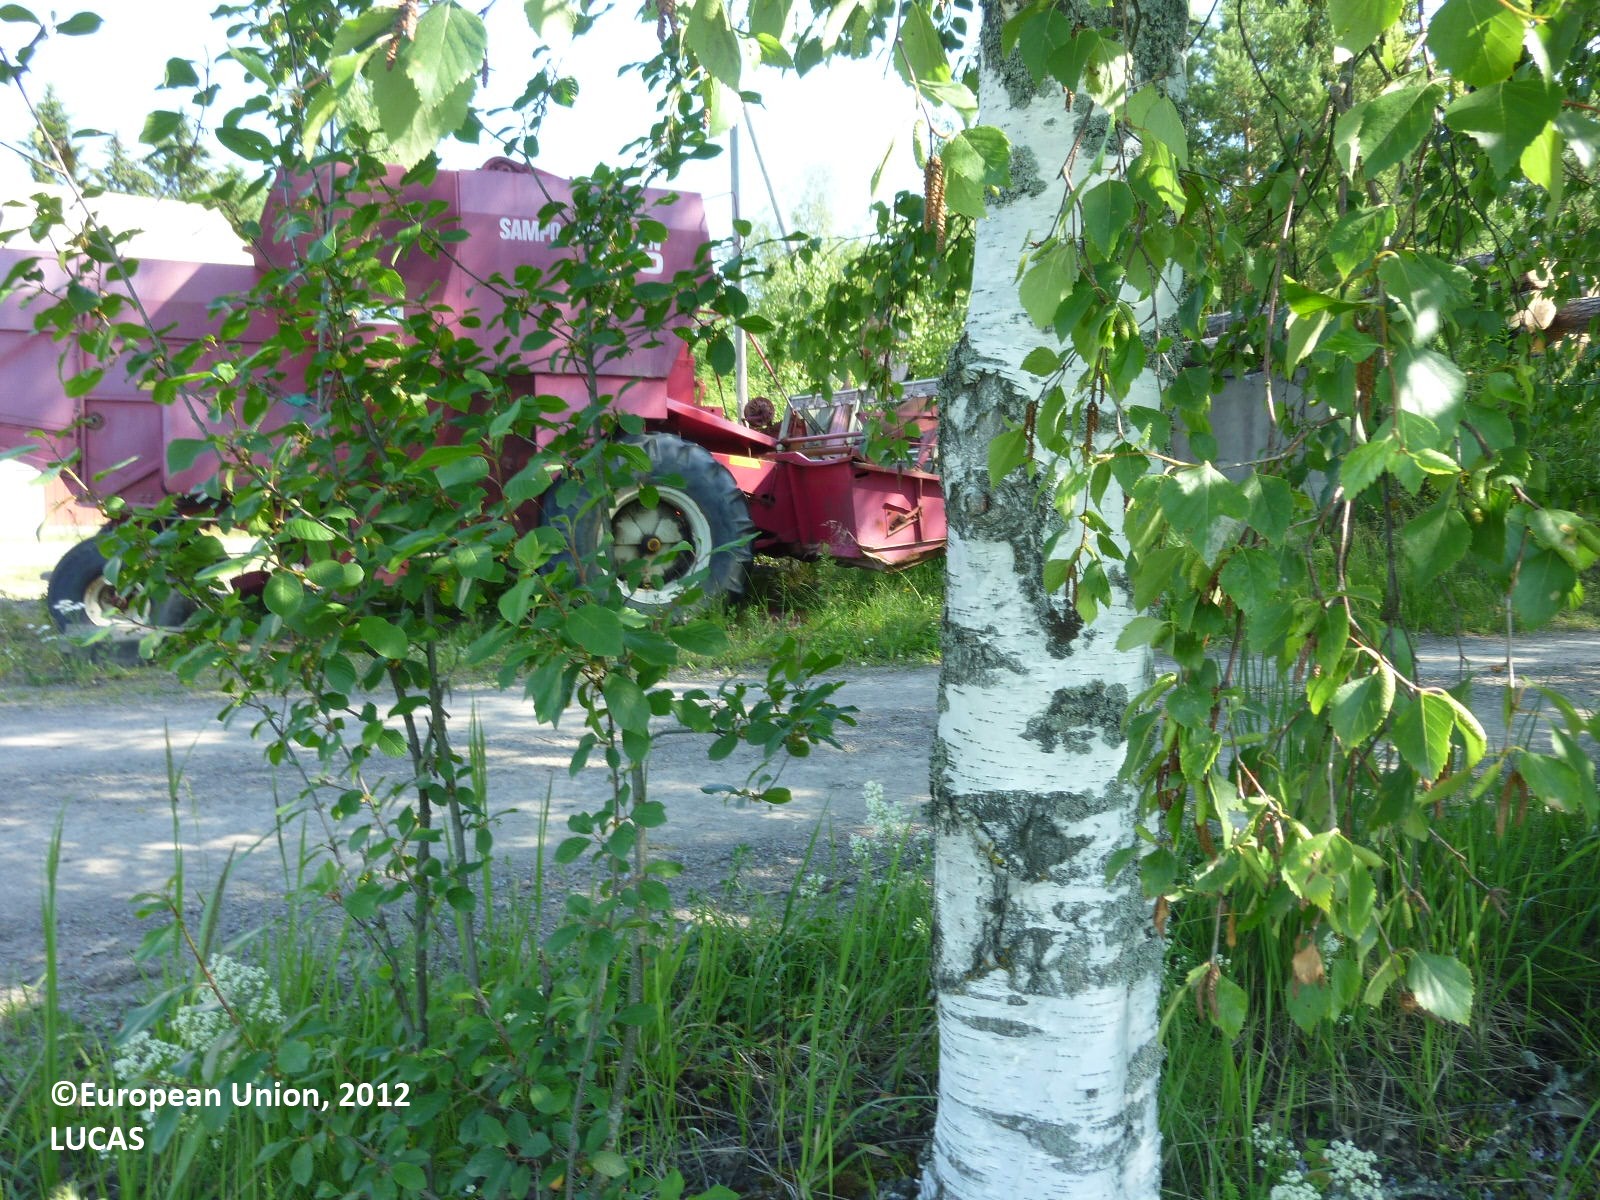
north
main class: Cropland
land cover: Oats
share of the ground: > 75 %
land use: Agriculture (excluding fallow land and kitchen gardens)
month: July
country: FI
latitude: 61.2931
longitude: 22.3997
